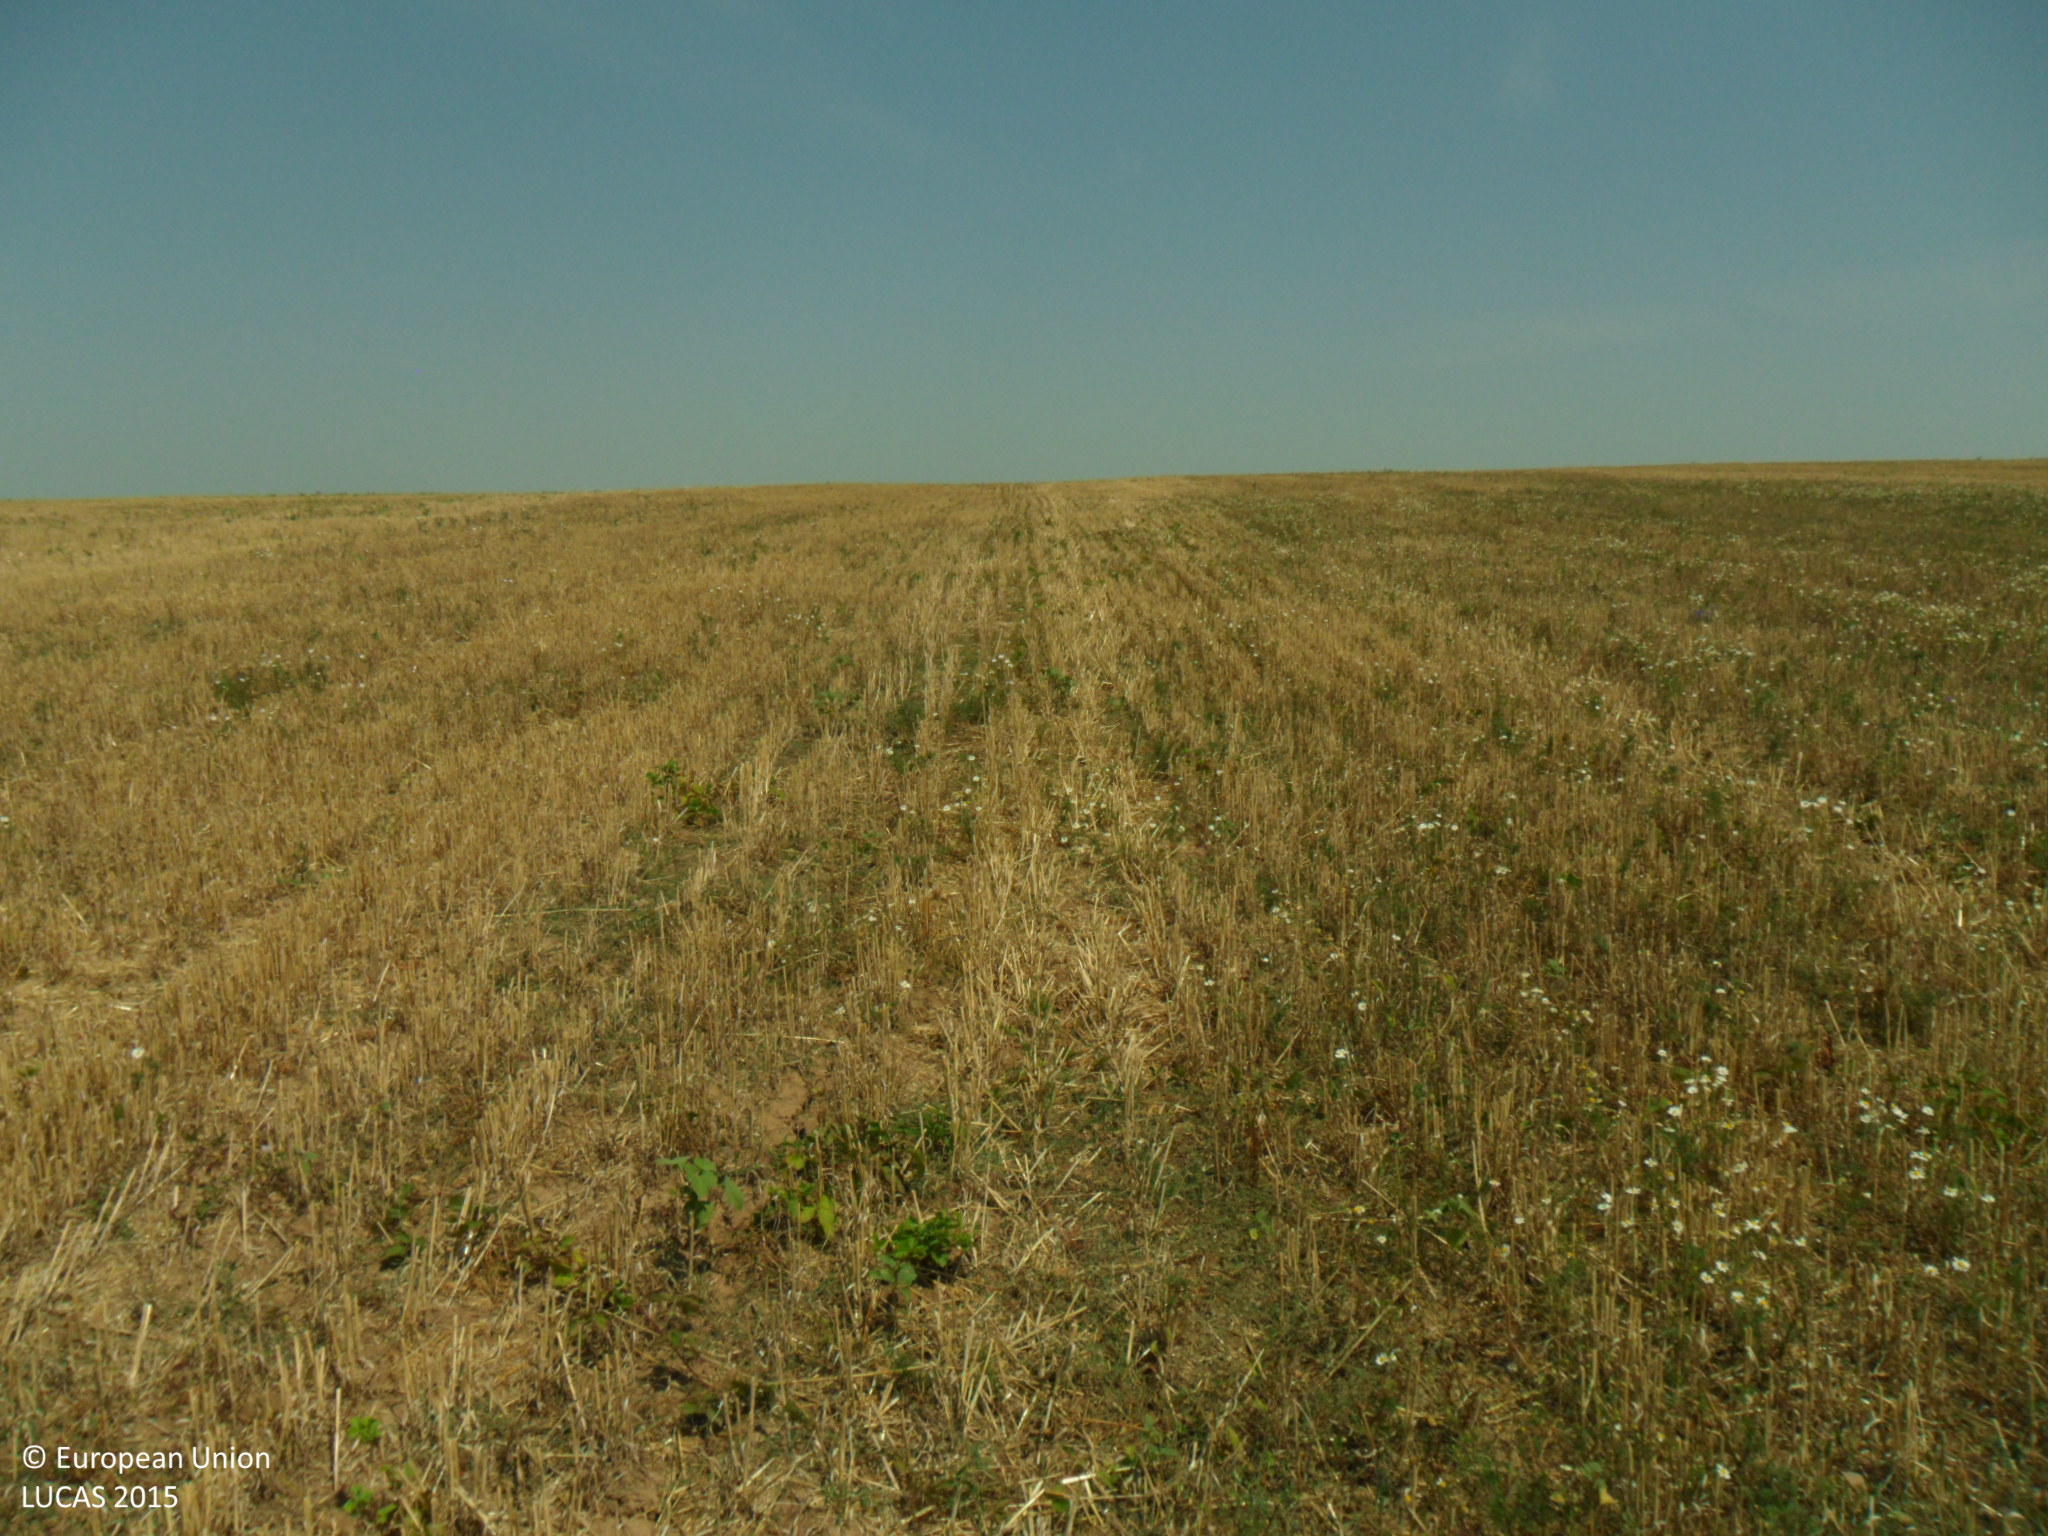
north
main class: Cropland
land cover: Common wheat
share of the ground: 25 - 50 %
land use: Agriculture (excluding fallow land and kitchen gardens)
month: August
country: BG
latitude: 43.4758
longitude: 26.7379
